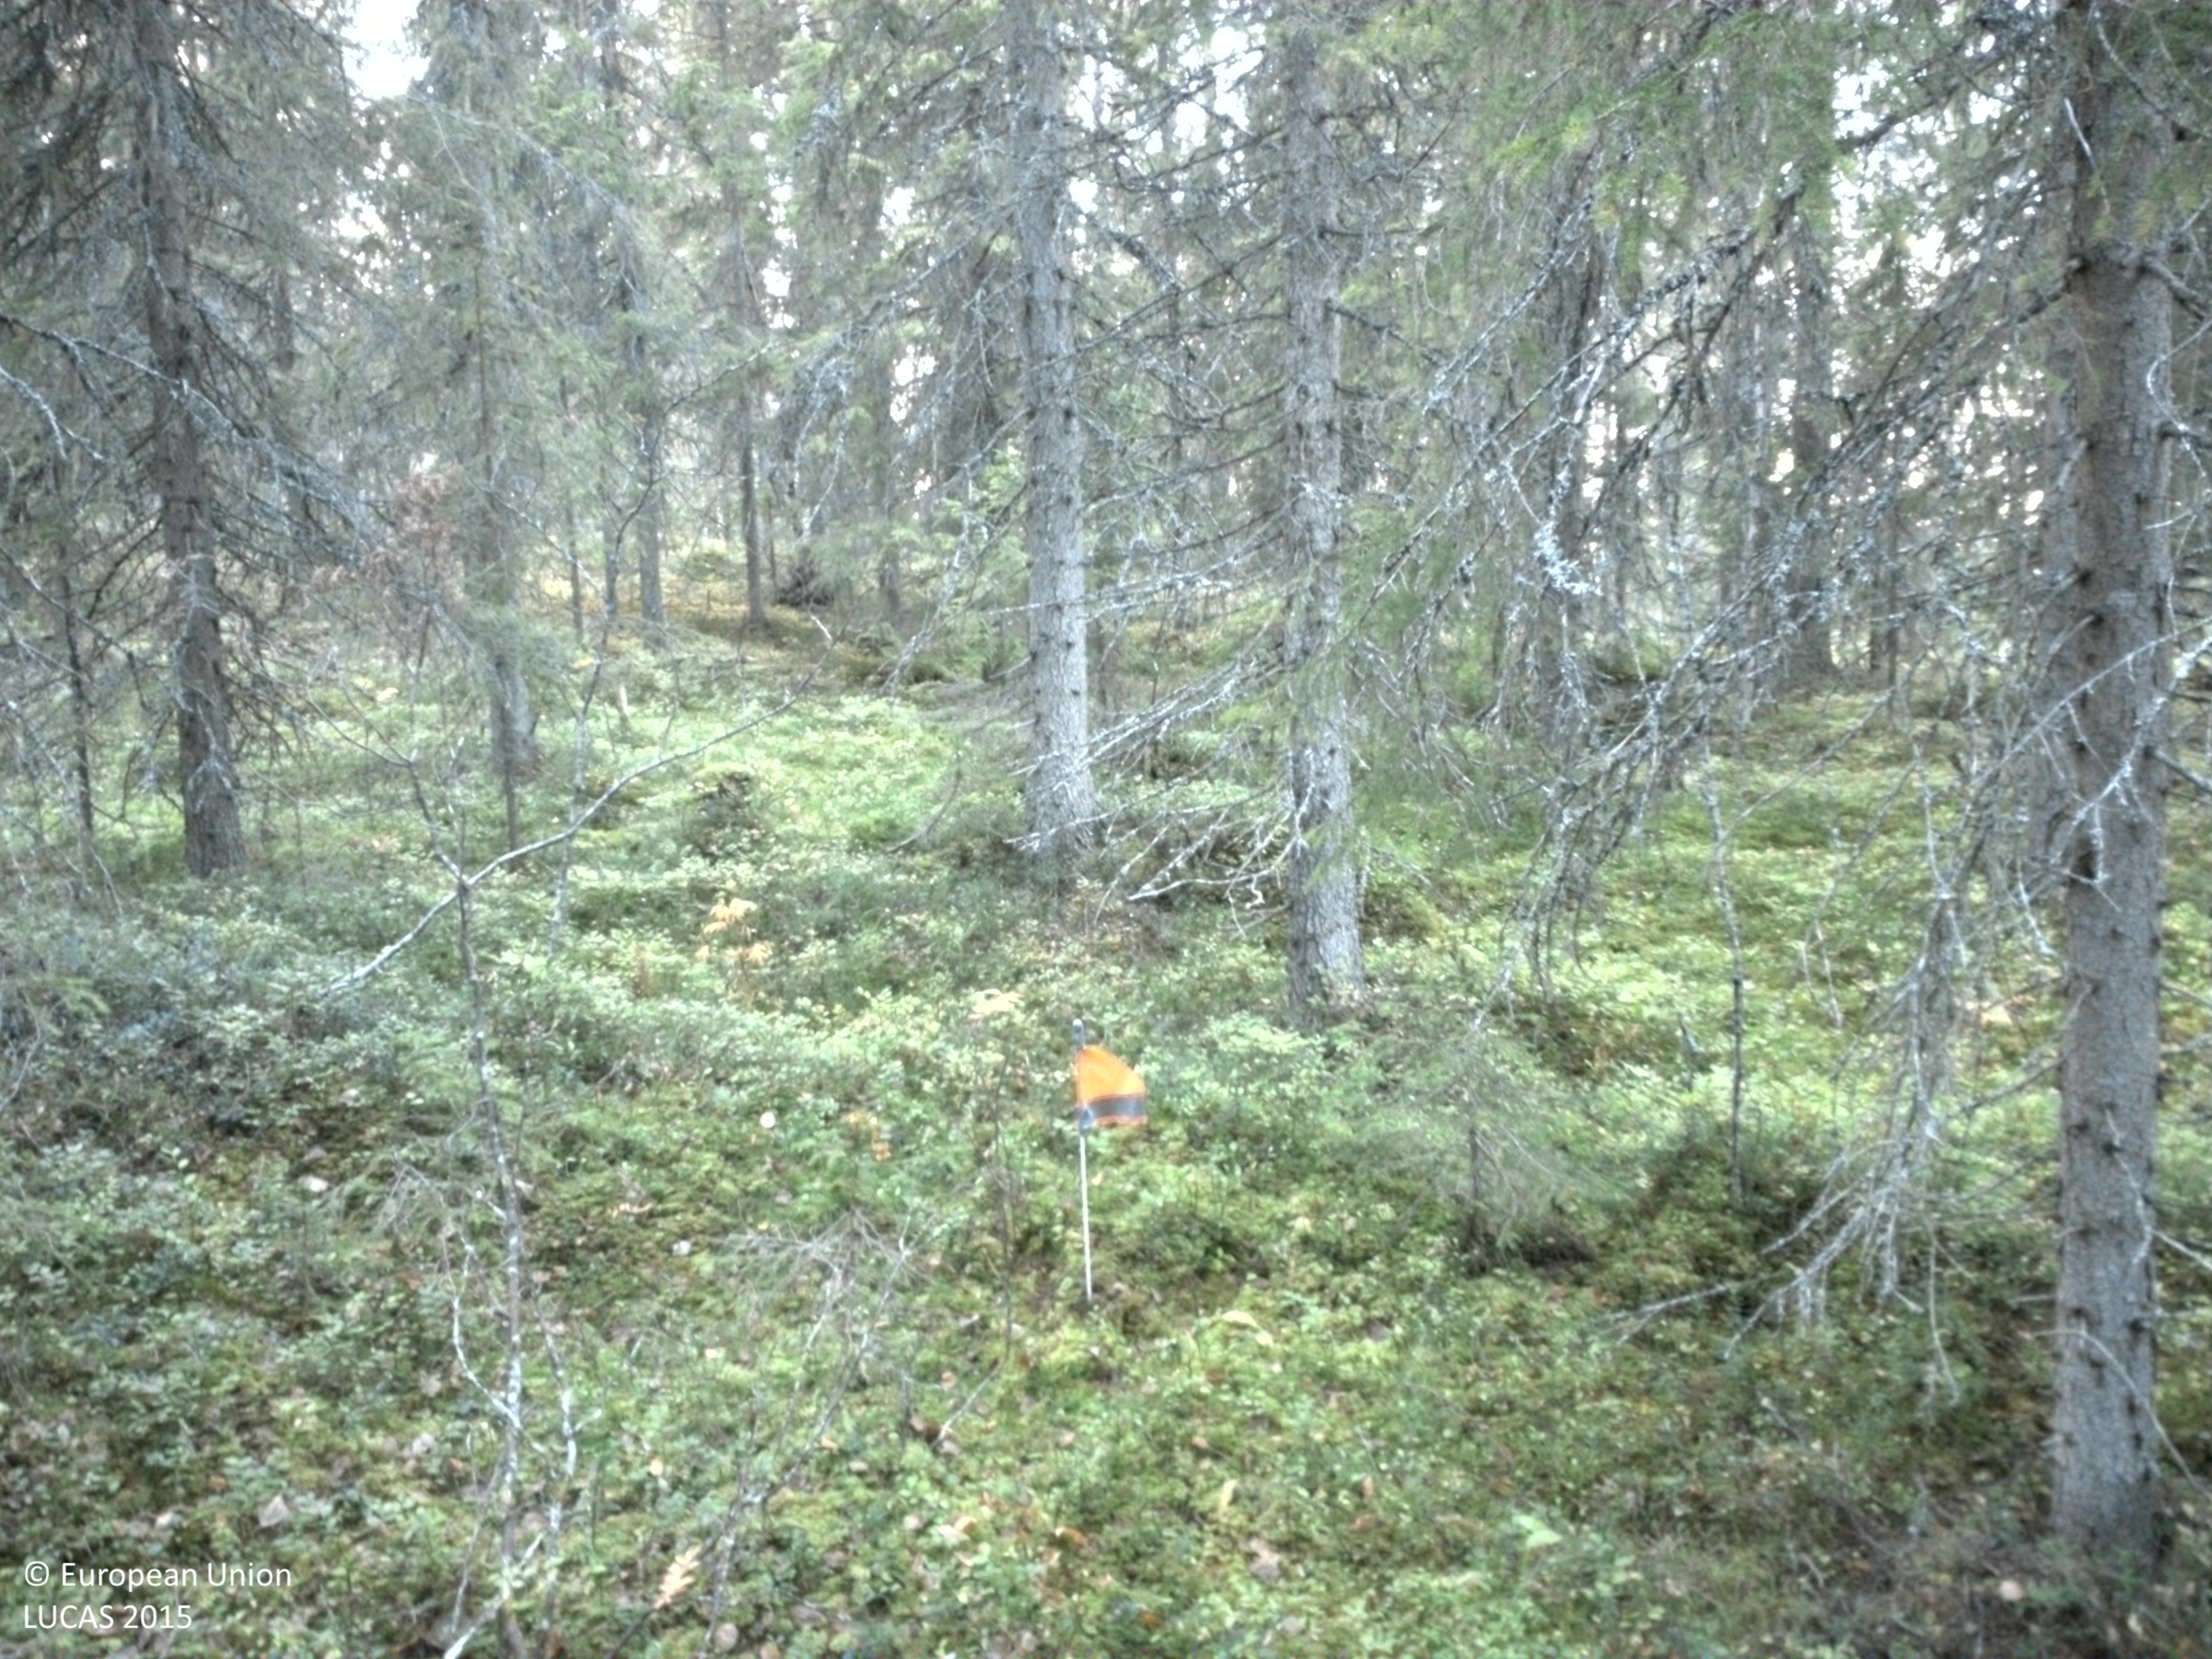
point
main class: Woodland
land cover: Spruce dominated coniferous woodland
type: boreal forest
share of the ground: 50 - 75 %
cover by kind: coniferous forest trees 45 %, shrubs 25 %, lichens and mosses 20 %, broadleaved forest trees 10 %
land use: Forestry
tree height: > 5 m
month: October
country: SE
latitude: 64.8026
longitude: 17.4804
